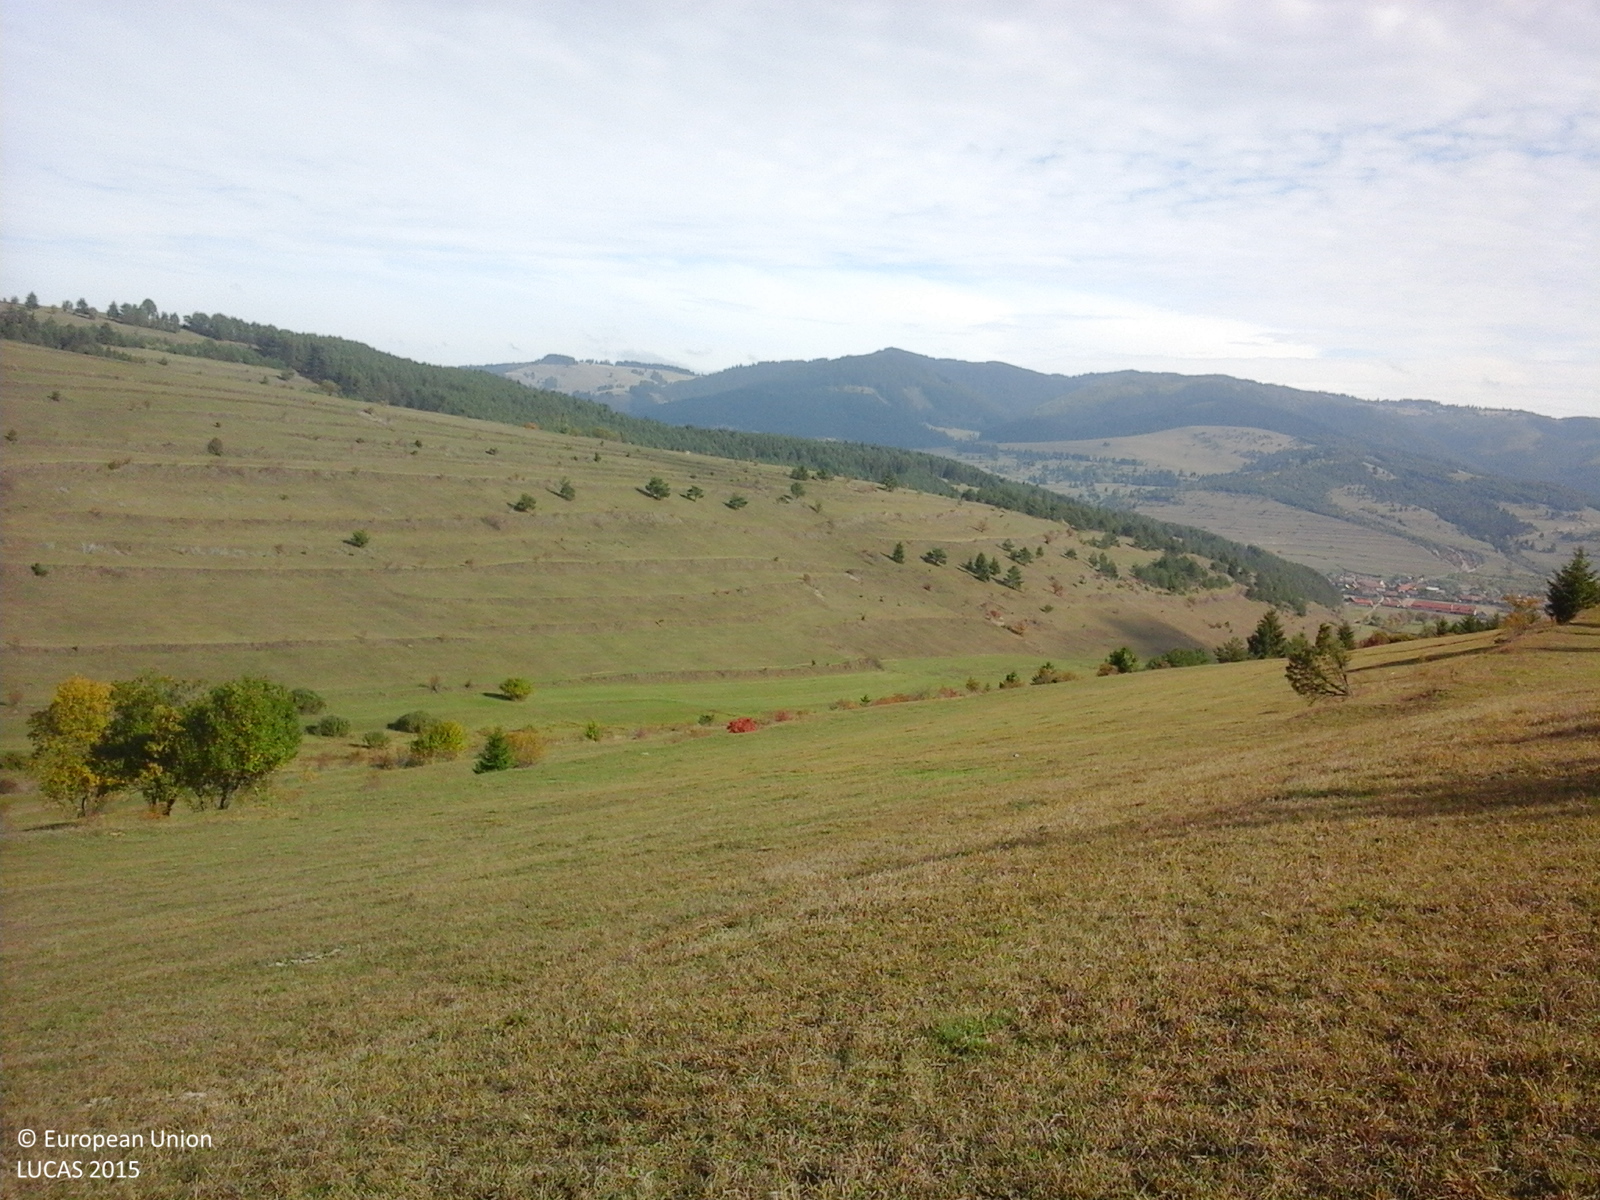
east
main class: Grassland
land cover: Grassland without tree/shrub cover
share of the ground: > 75 %
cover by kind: herbaceous plants 100 %
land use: Agriculture (excluding fallow land and kitchen gardens)
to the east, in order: Grassland without tree/shrub cover; Lines of trees; Grassland without tree/shrub cover; Lines of trees; Grassland without tree/shrub cover; Lines of trees; Grassland without tree/shrub cover; Lines of trees; Grassland without tree/shrub cover
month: October
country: RO
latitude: 46.3225
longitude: 25.9243
